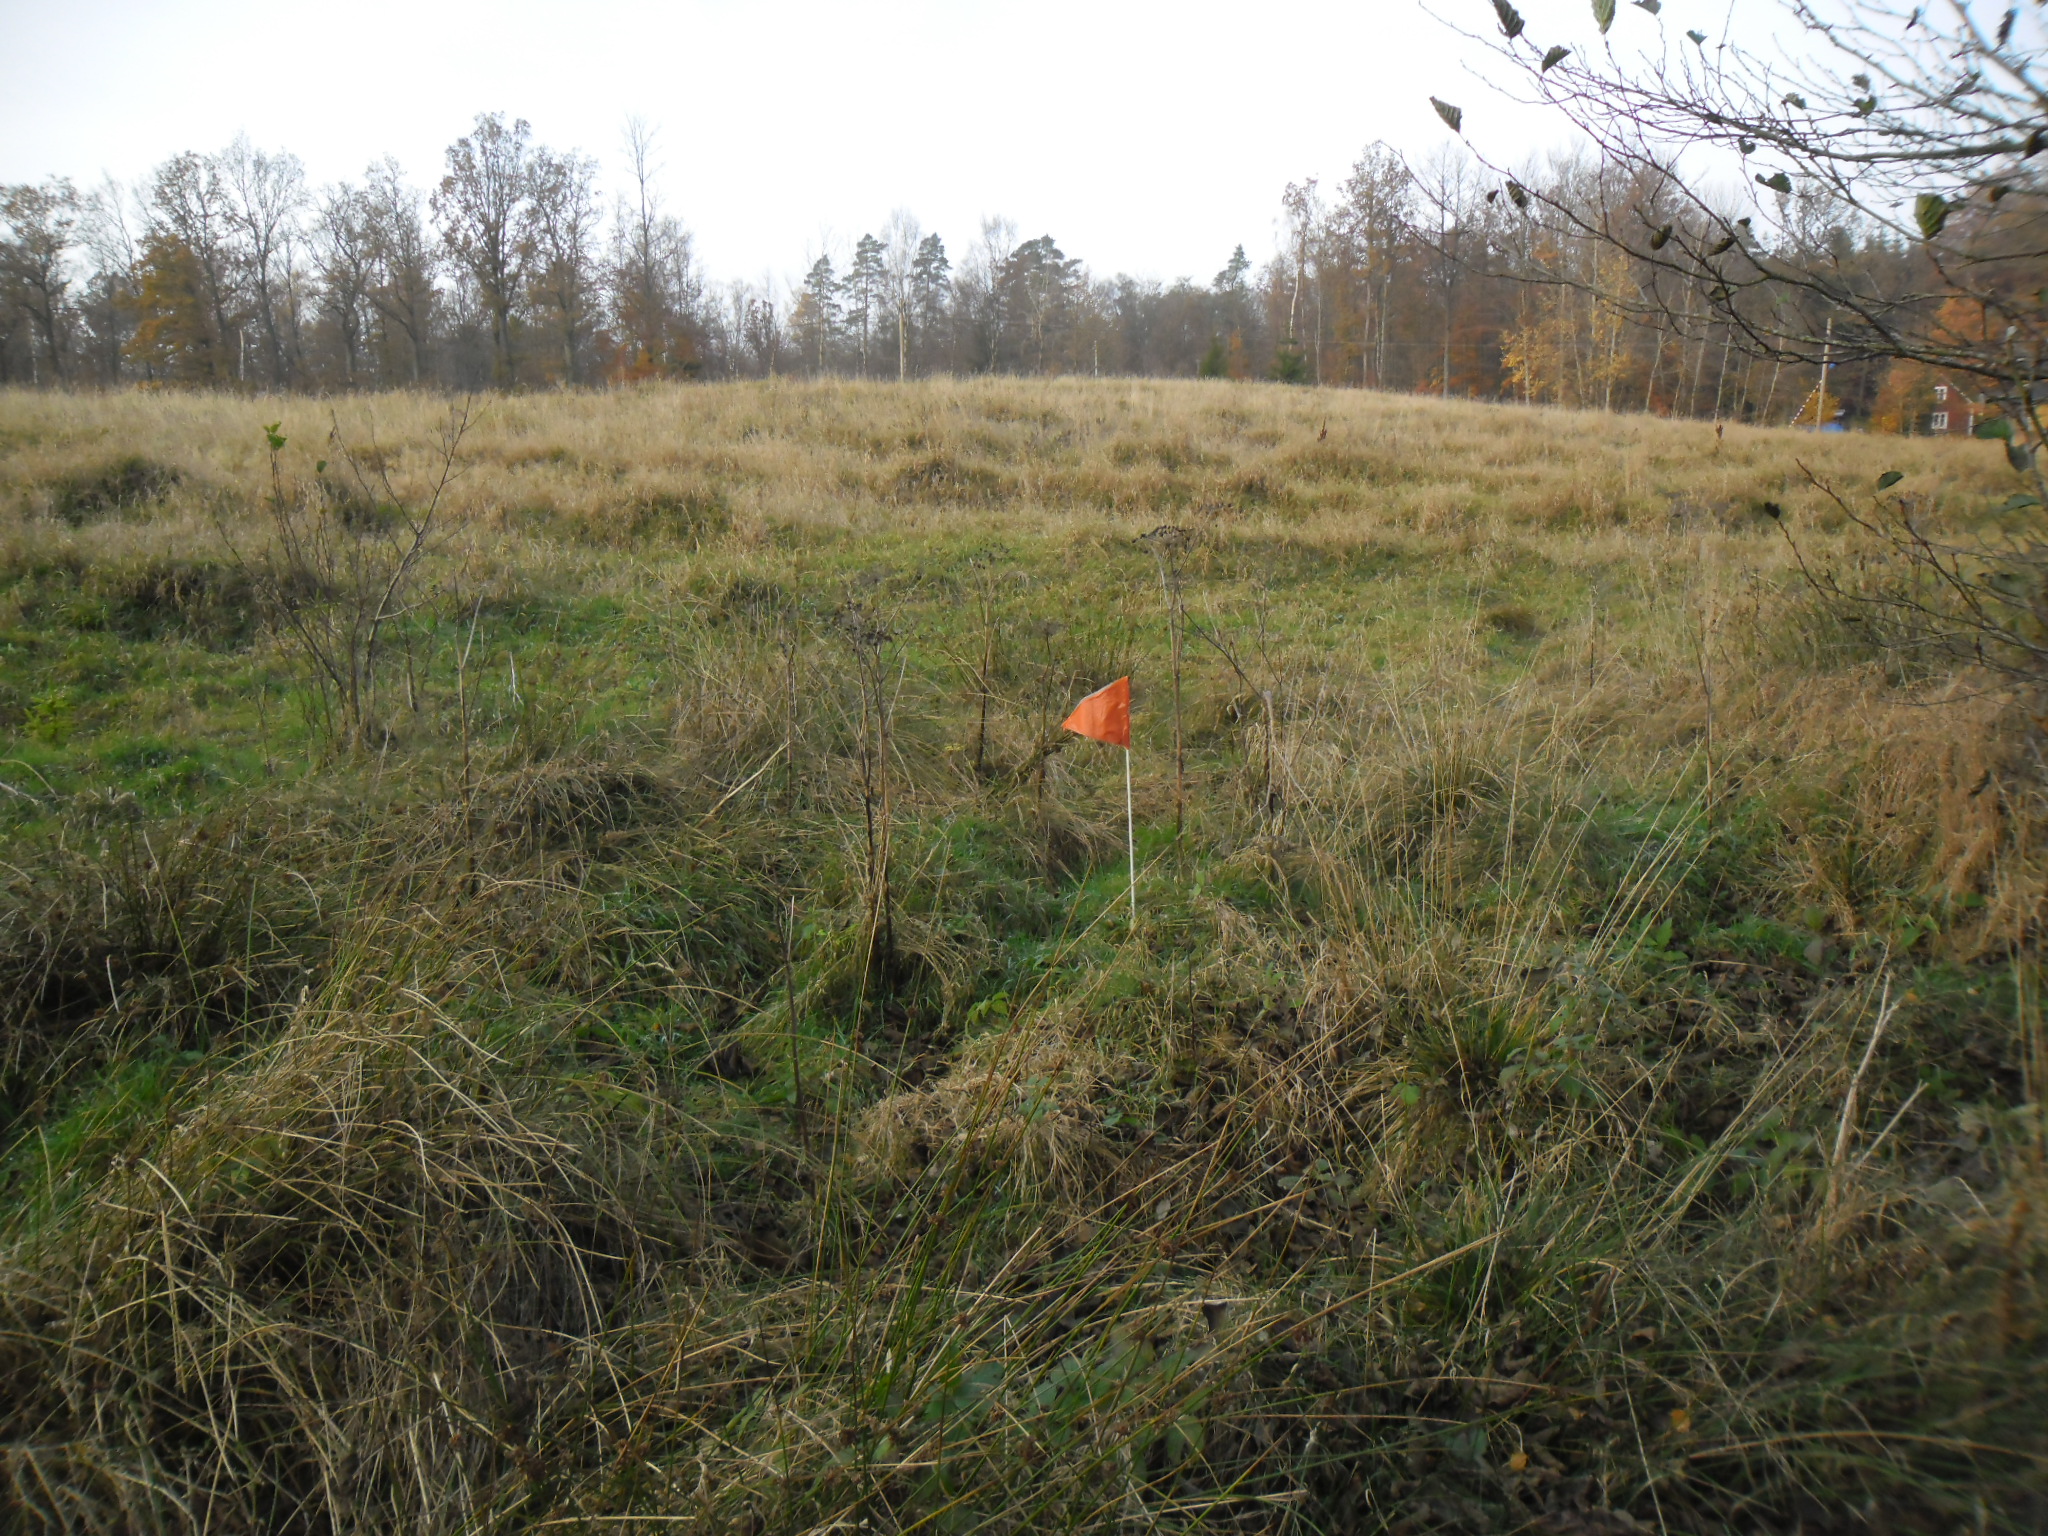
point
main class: Grassland
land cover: Grassland without tree/shrub cover
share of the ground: > 75 %
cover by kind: herbaceous plants 100 %
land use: Semi-natural and natural areas not in use
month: November
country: SE
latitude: 56.2580
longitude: 13.1128
